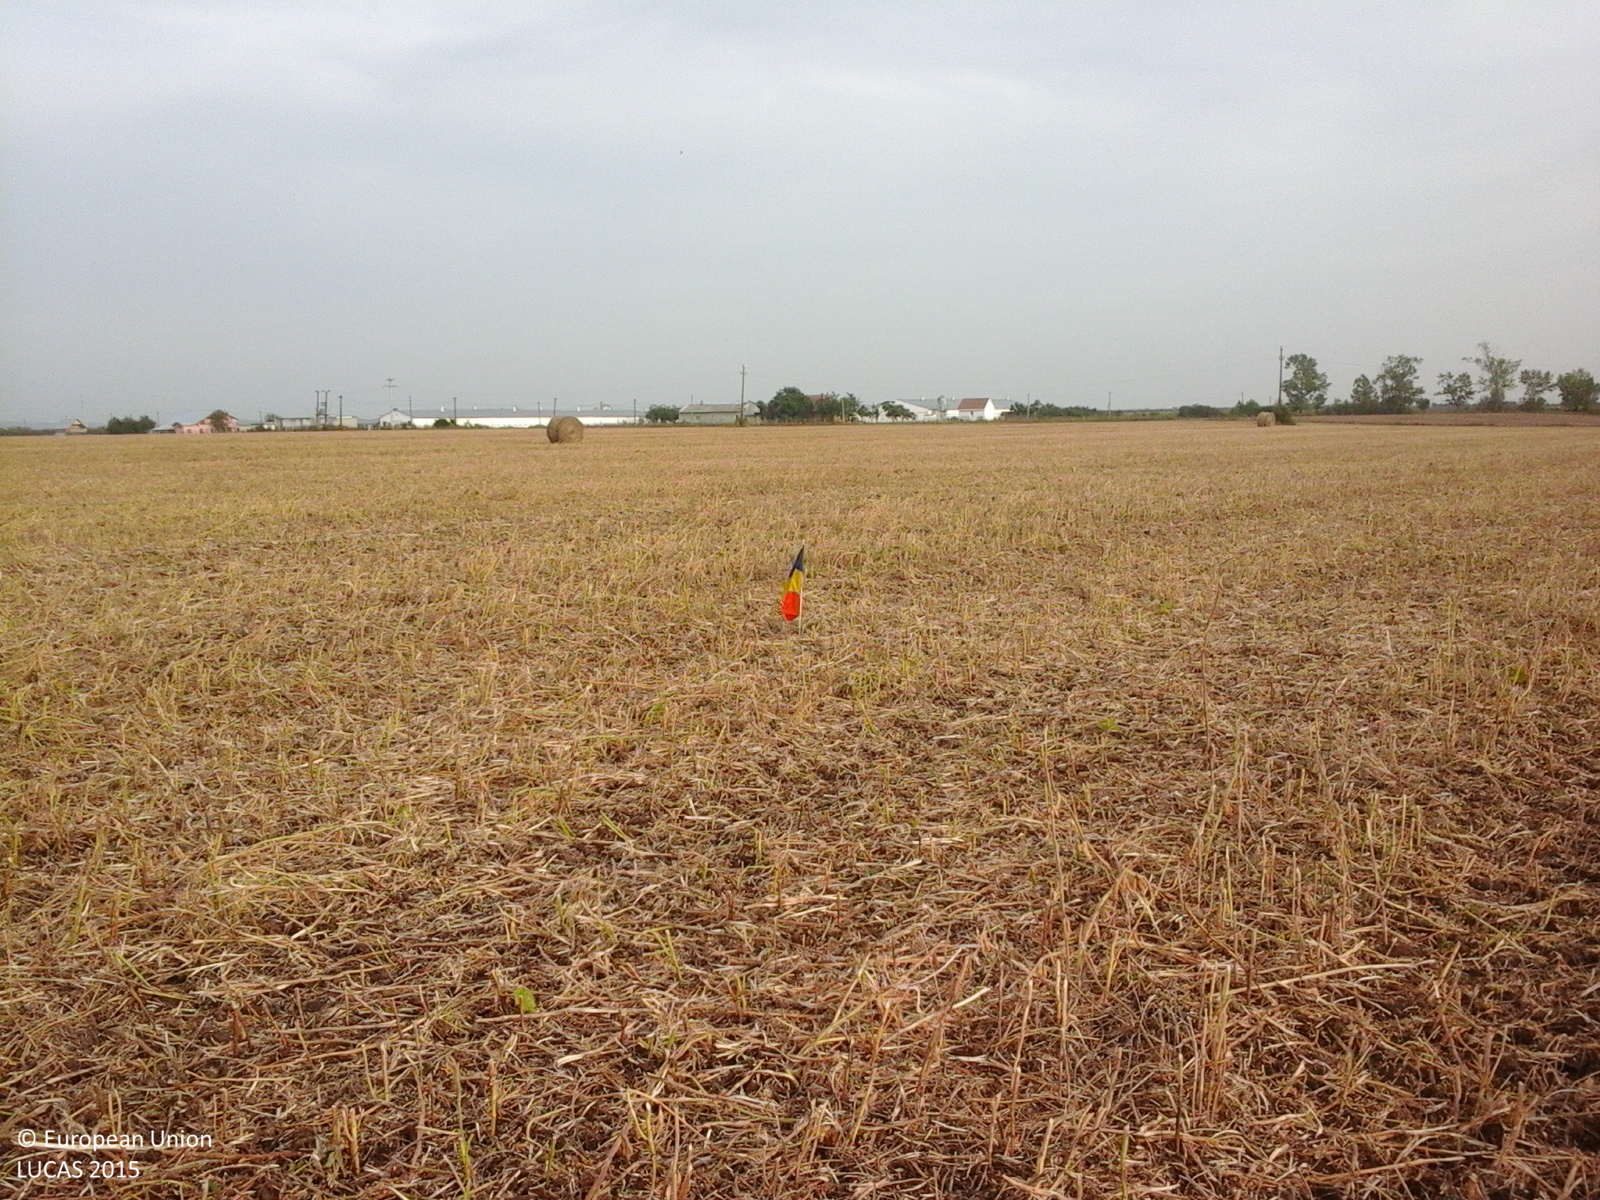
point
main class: Cropland
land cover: Soya
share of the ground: 50 - 75 %
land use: Agriculture (excluding fallow land and kitchen gardens)
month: September
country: RO
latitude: 46.5817
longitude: 23.8154
